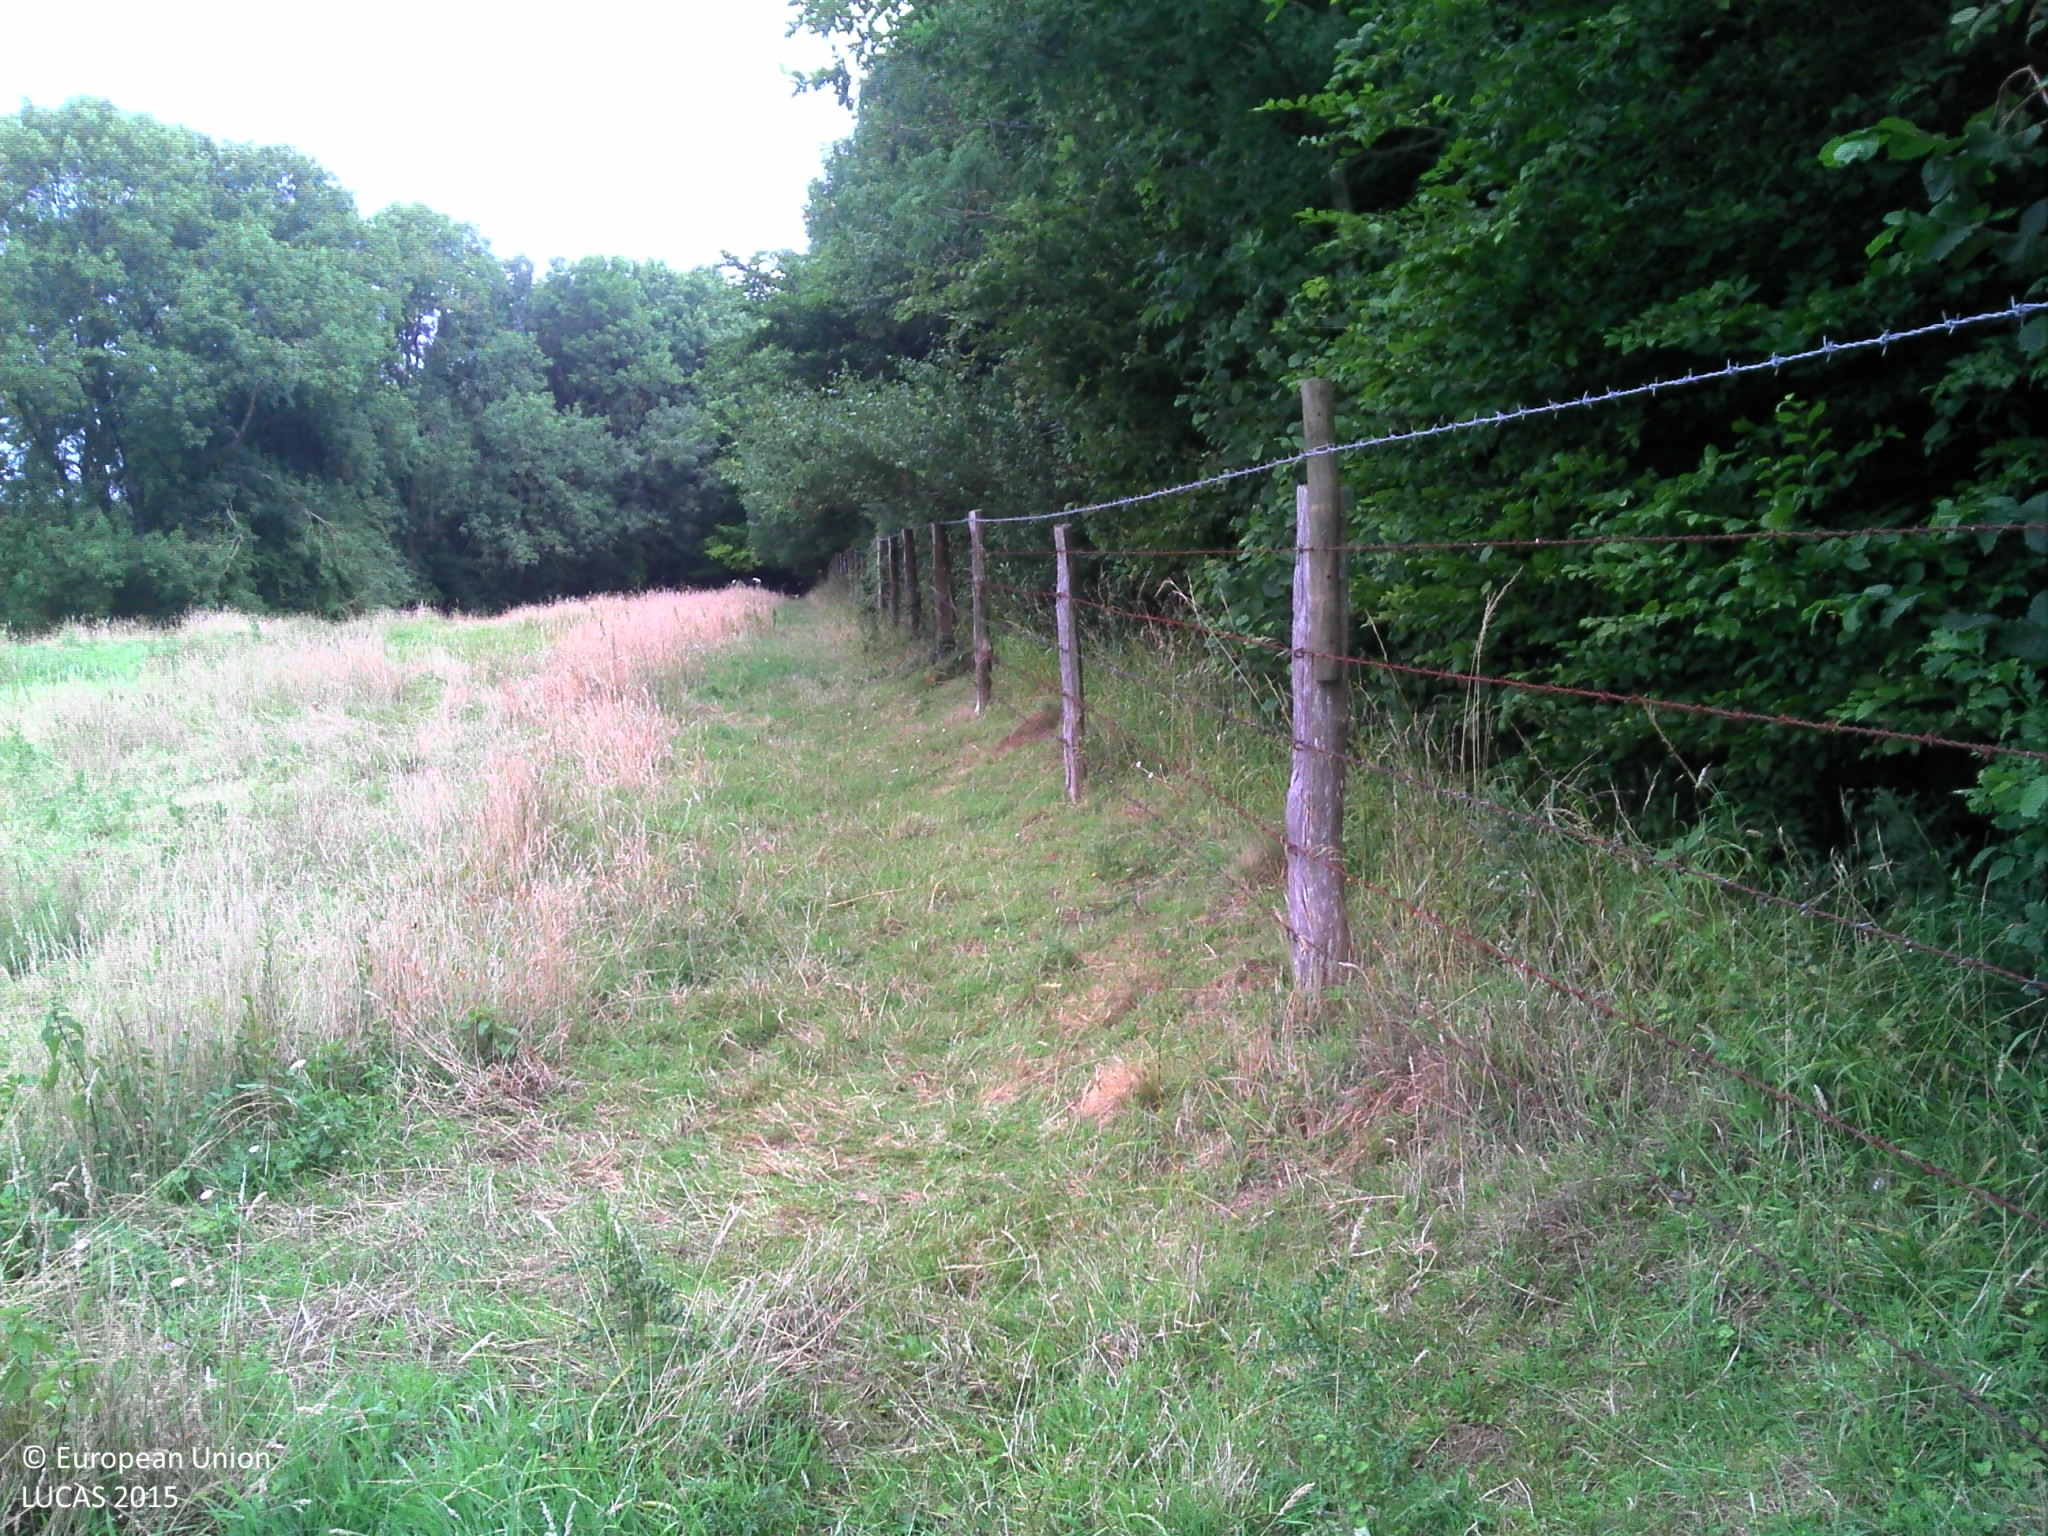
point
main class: Grassland
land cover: Grassland without tree/shrub cover
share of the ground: > 75 %
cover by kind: herbaceous plants 100 %
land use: Agriculture (excluding fallow land and kitchen gardens)
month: July
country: FR
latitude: 50.1332
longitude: 2.1933
